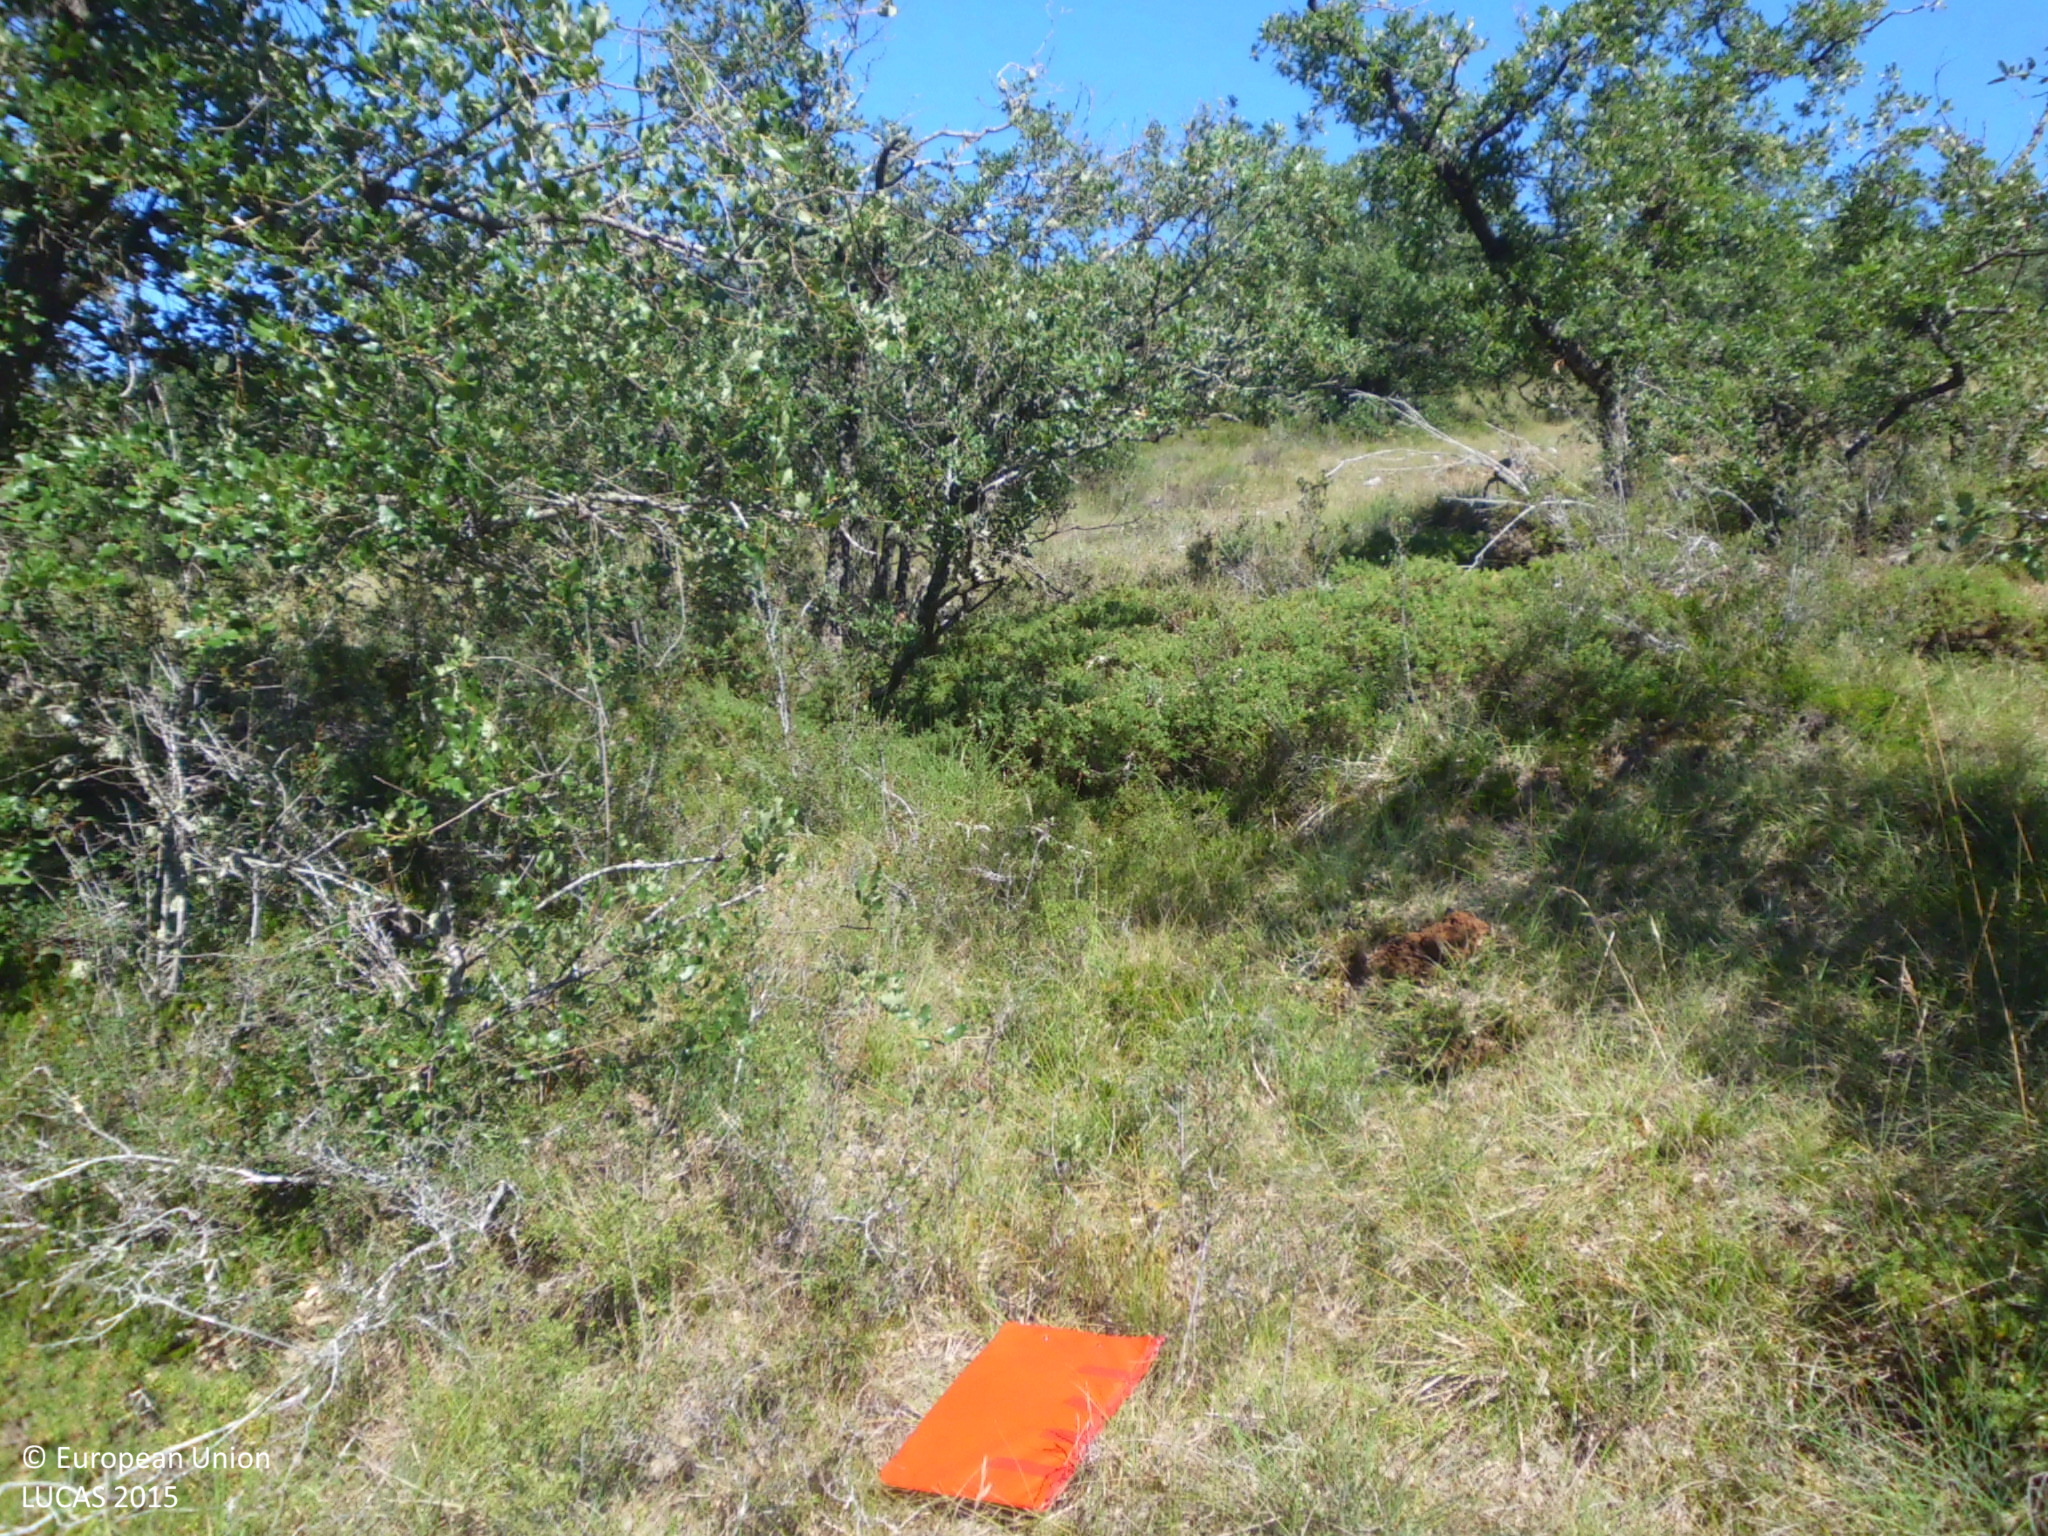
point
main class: Woodland
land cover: Broadleaved woodland
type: broadleaved evergreen forest
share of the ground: 25 - 50 %
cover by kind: broadleaved forest trees 40 %, herbaceous plants 30 %, consolidated bare surface 20 %, shrubs 10 %
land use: Semi-natural and natural areas not in use
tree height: > 5 m
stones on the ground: 10 - 25 %
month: July
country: ES
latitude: 42.7953
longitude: -4.3689
